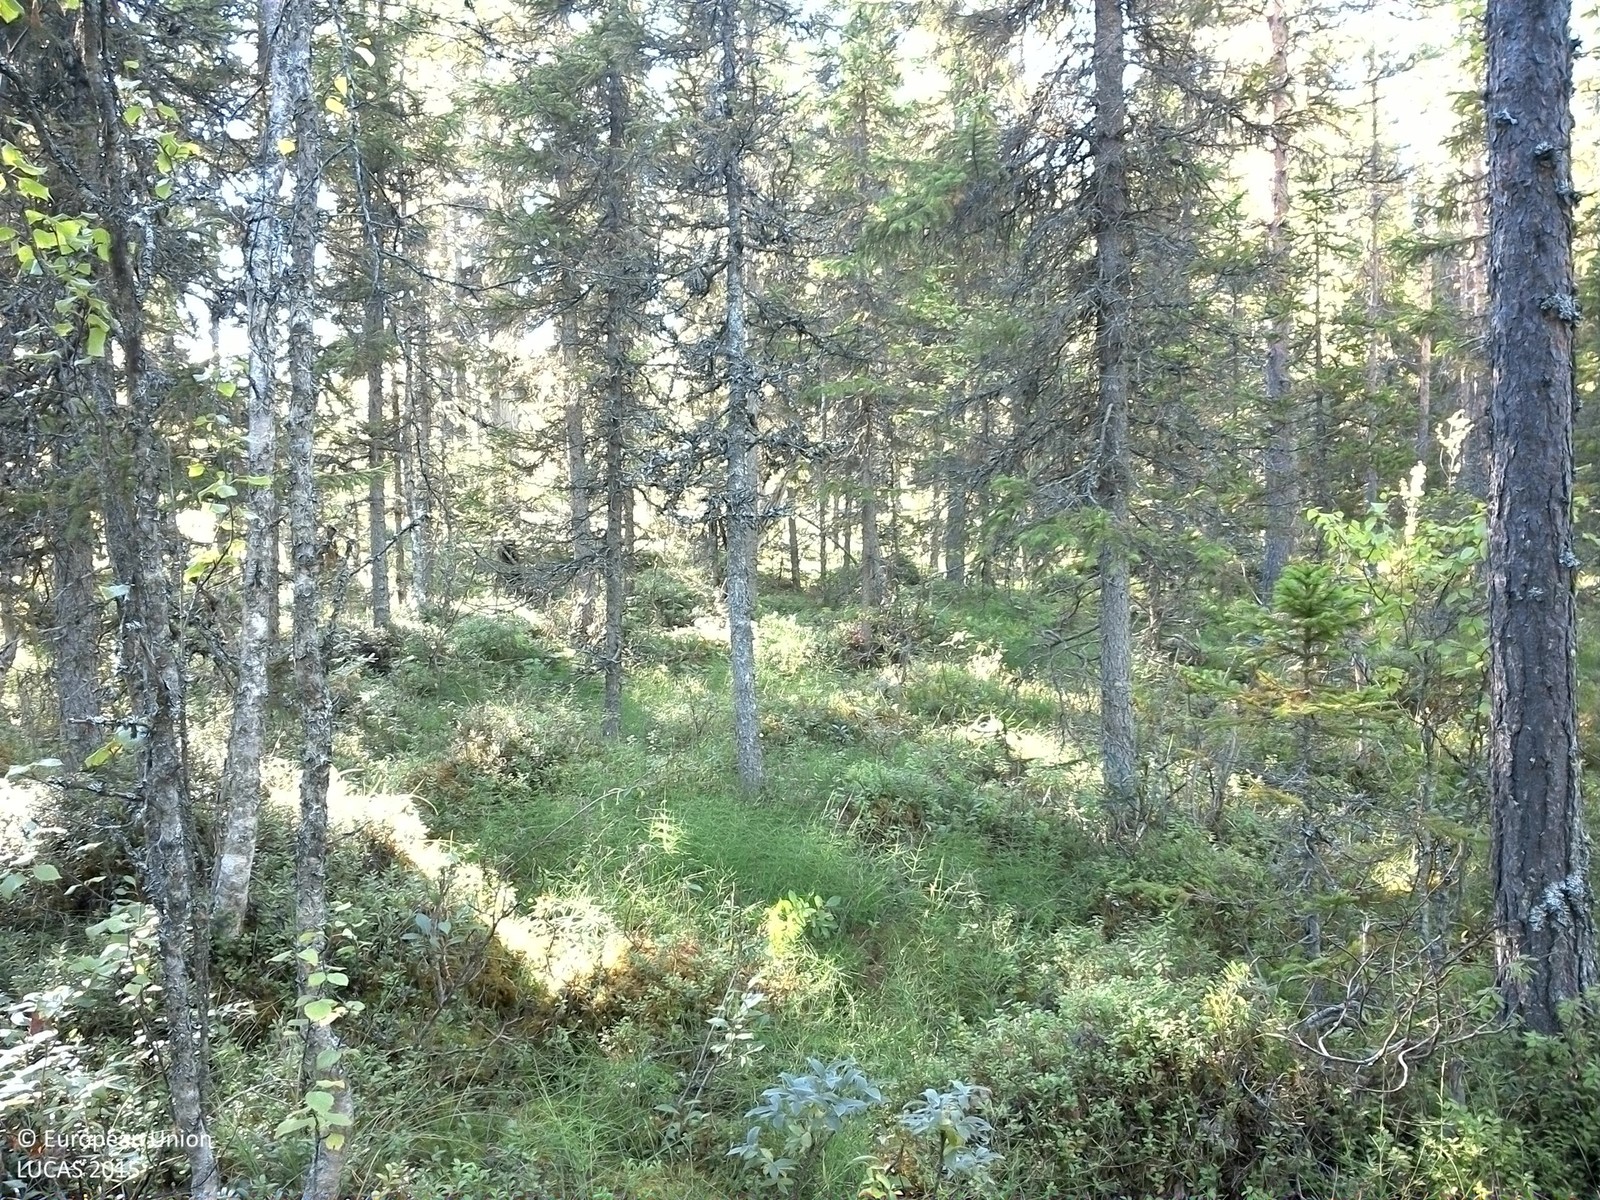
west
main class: Woodland
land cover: Other coniferous woodland
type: boreal forest
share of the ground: 50 - 75 %
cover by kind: coniferous forest trees 50 %, shrubs 35 %, lichens and mosses 10 %, broadleaved forest trees 5 %
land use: Forestry
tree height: > 5 m
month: September
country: SE
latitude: 63.8594
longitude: 16.6647
